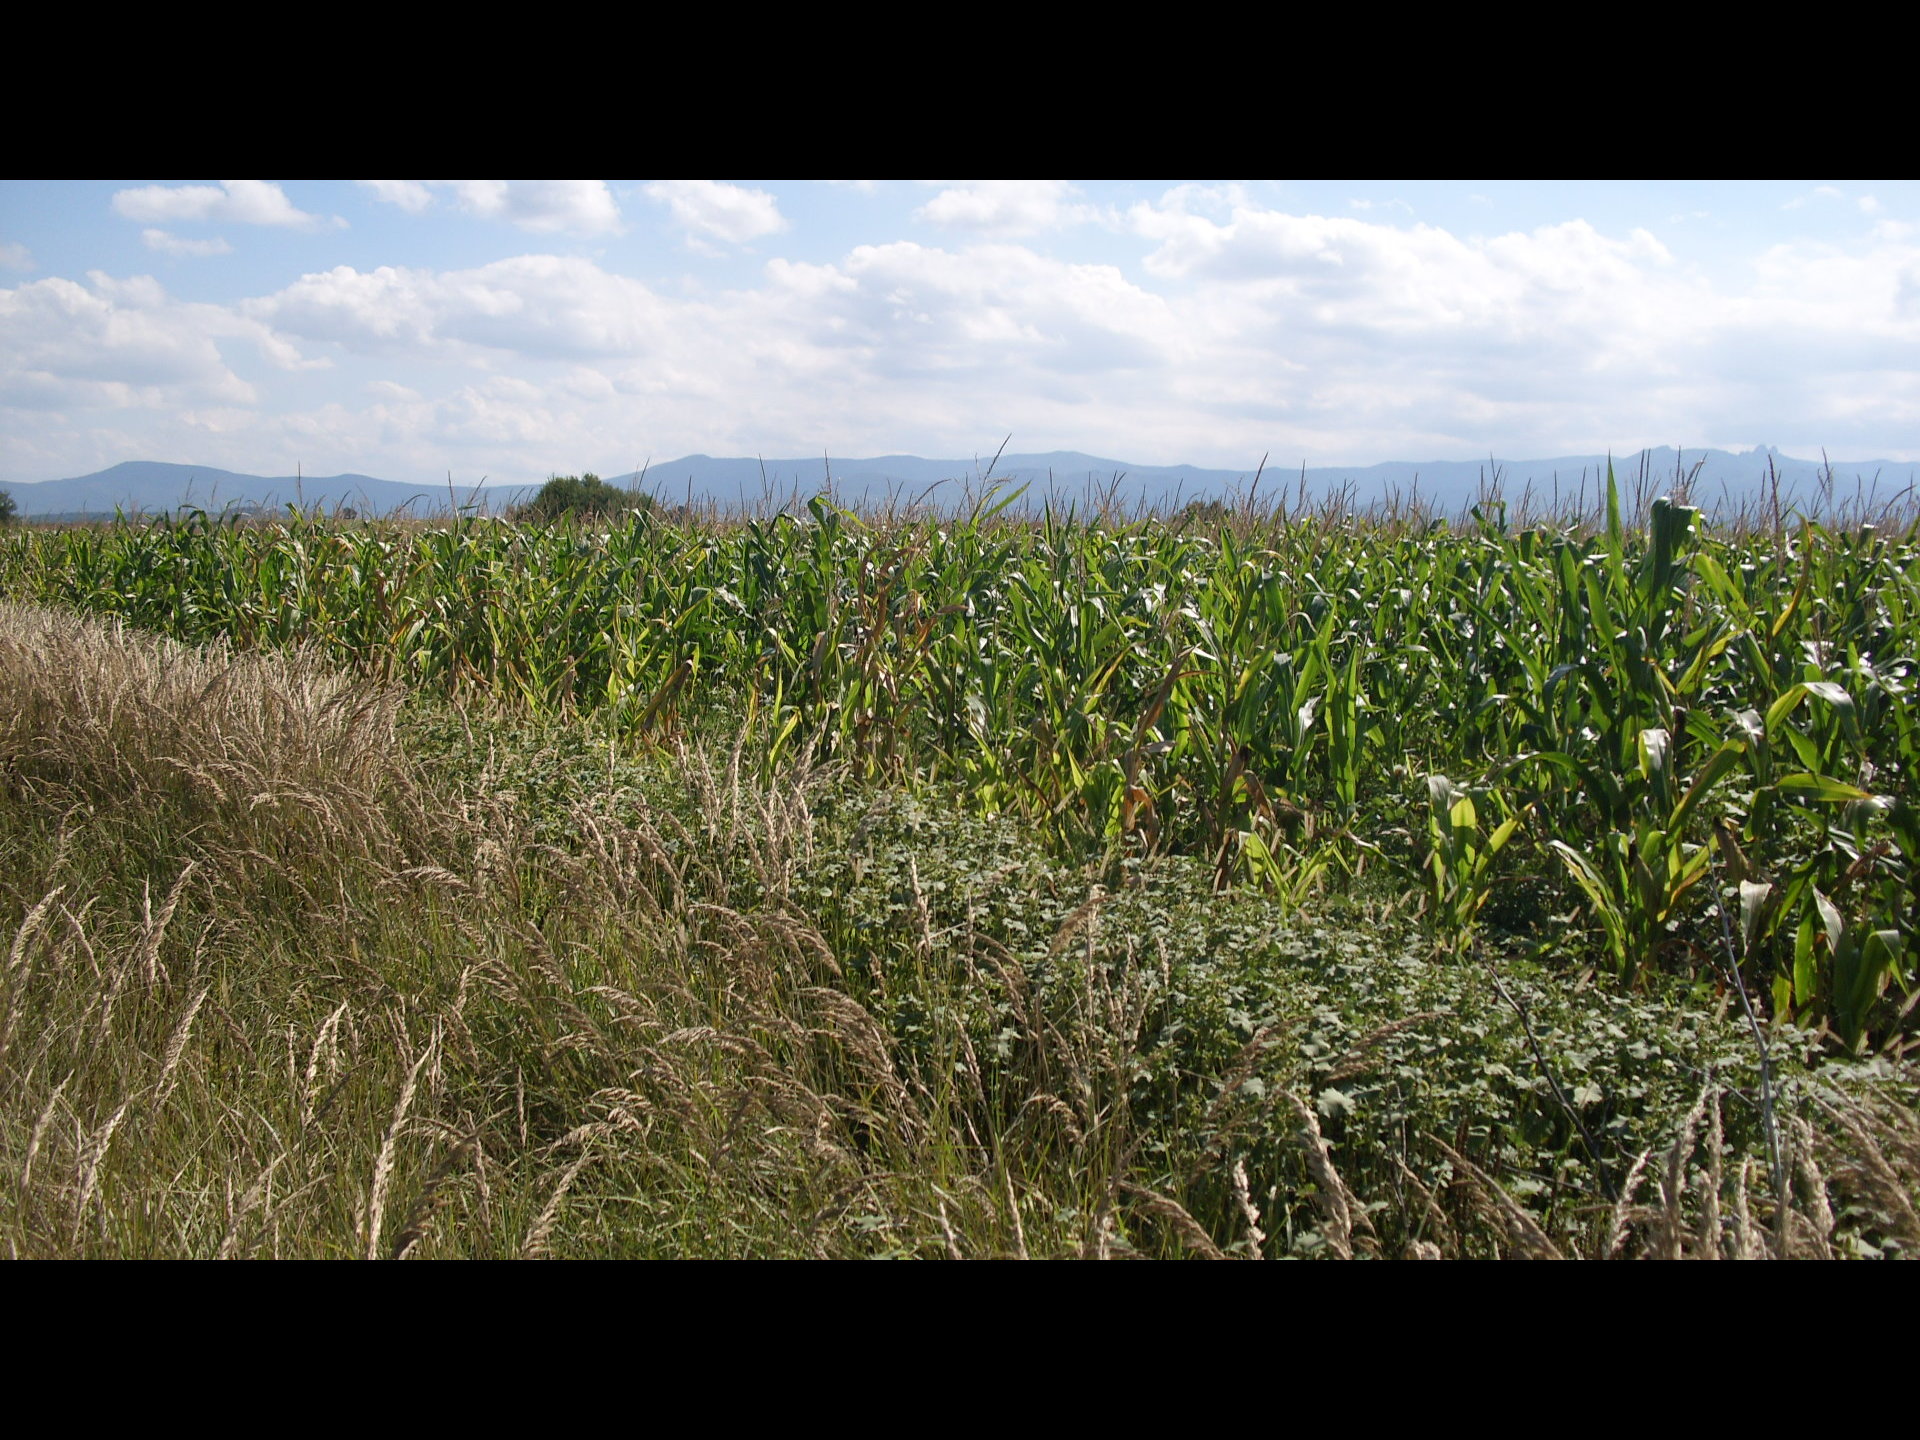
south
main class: Grassland
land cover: Grassland without tree/shrub cover
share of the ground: > 75 %
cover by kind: herbaceous plants 100 %
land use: Agriculture (excluding fallow land and kitchen gardens)
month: August
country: BG
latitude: 43.5862
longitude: 22.9801
